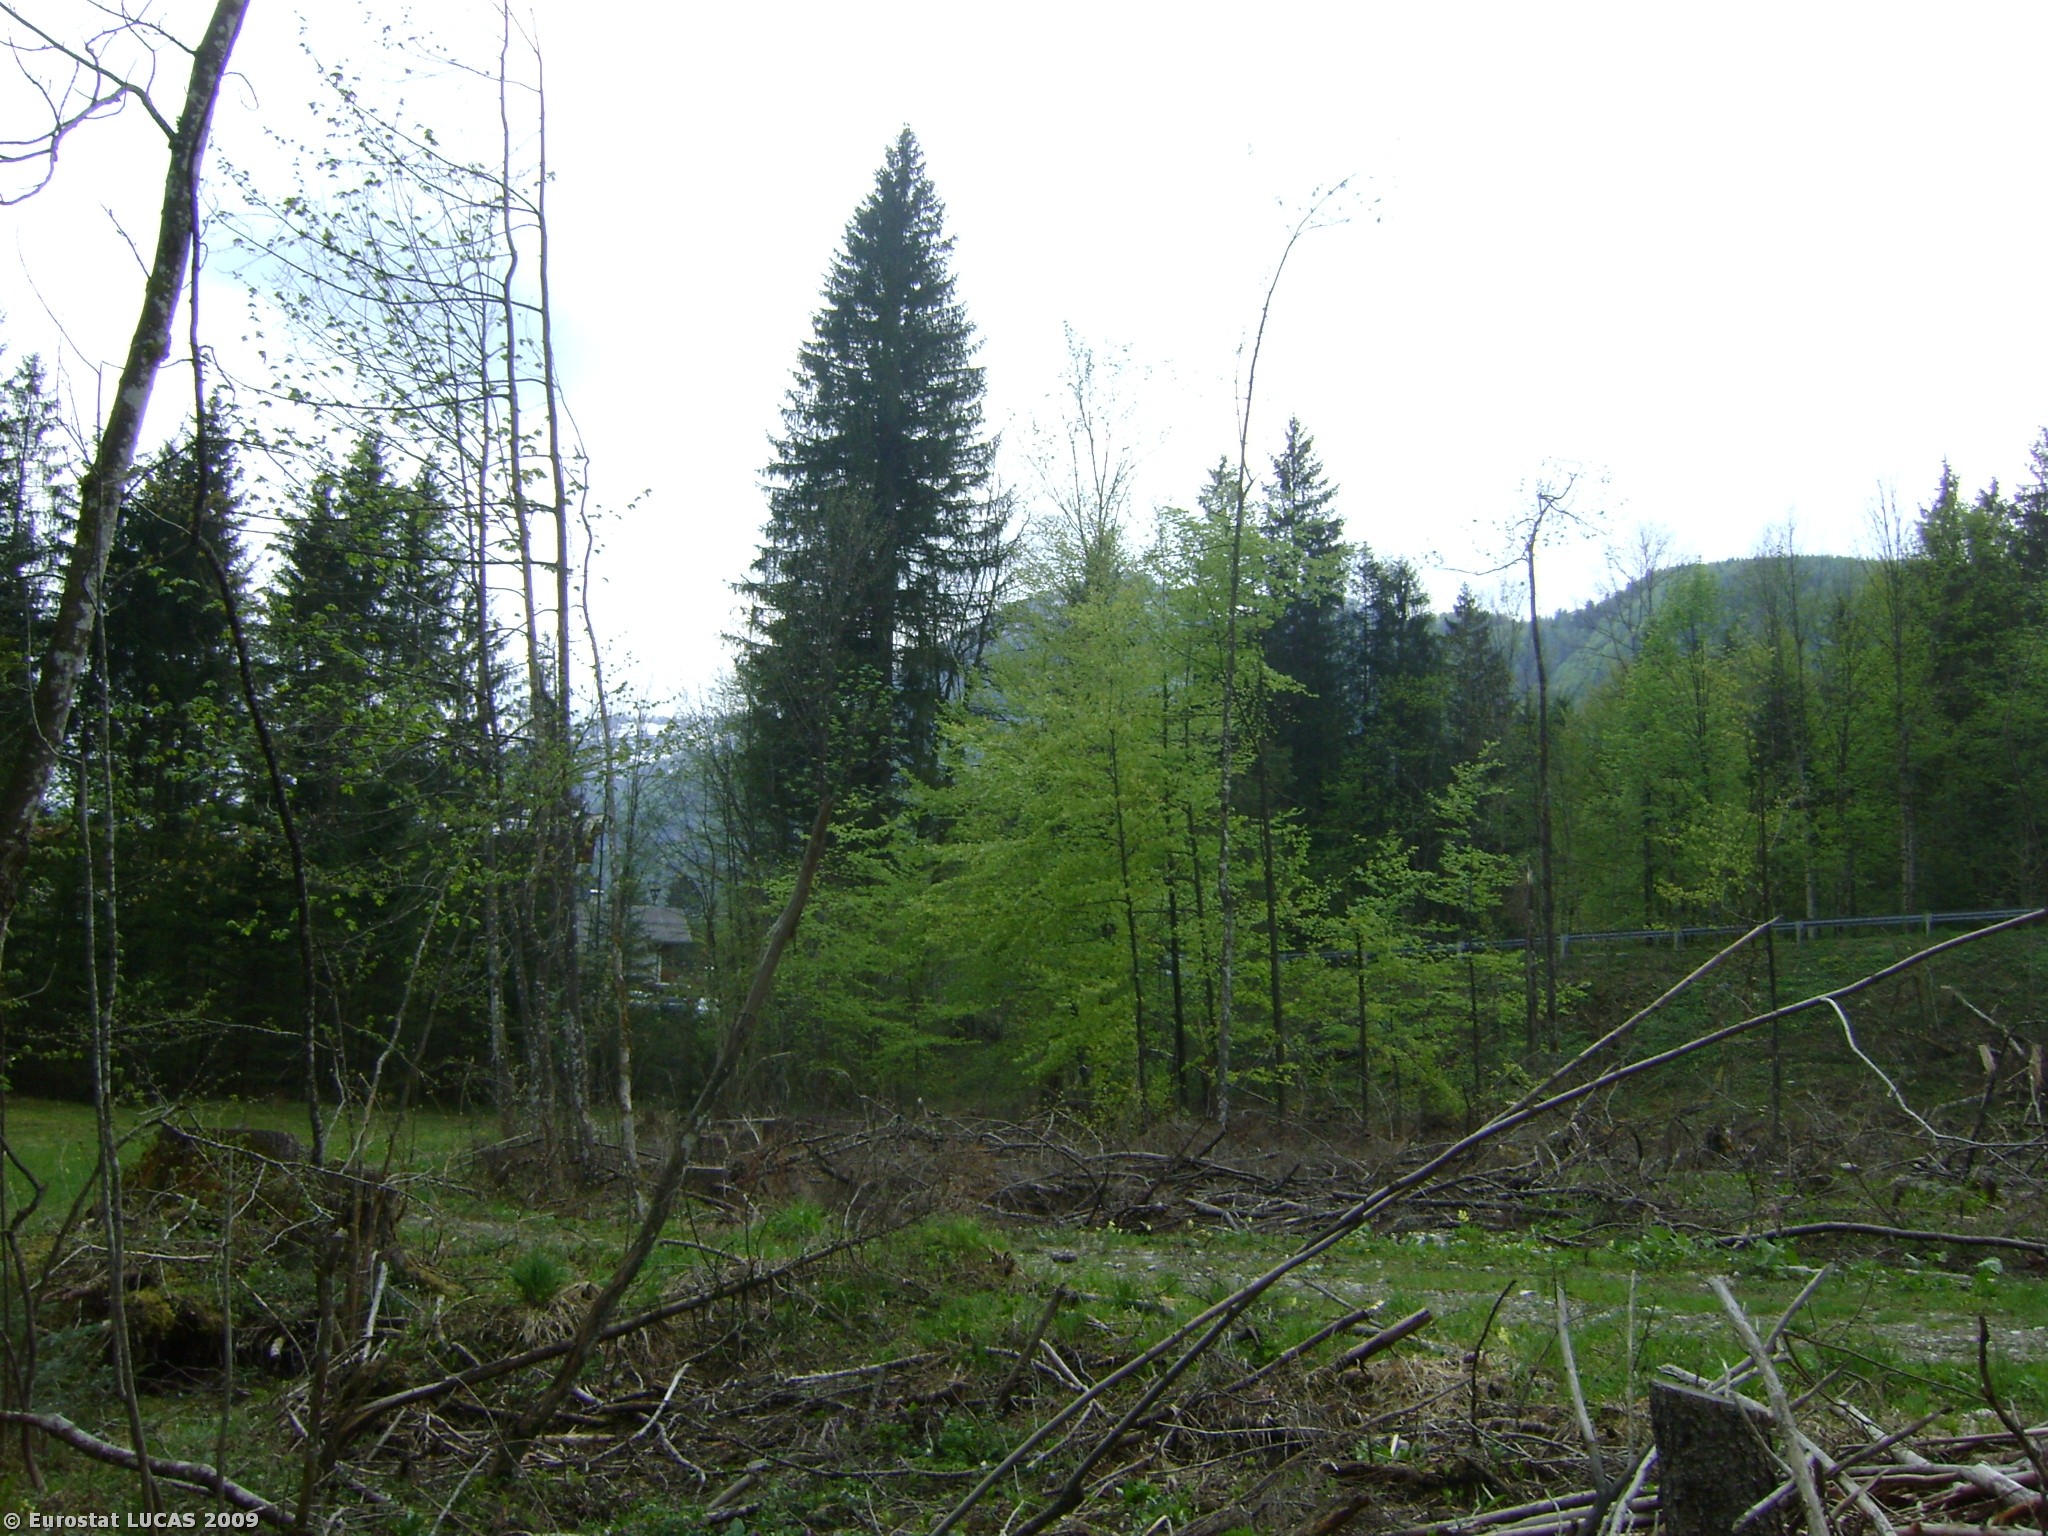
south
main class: Woodland
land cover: Mixed woodland
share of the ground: 50 - 75 %
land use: Forestry
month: May
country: AT
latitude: 47.7617
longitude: 13.2406
